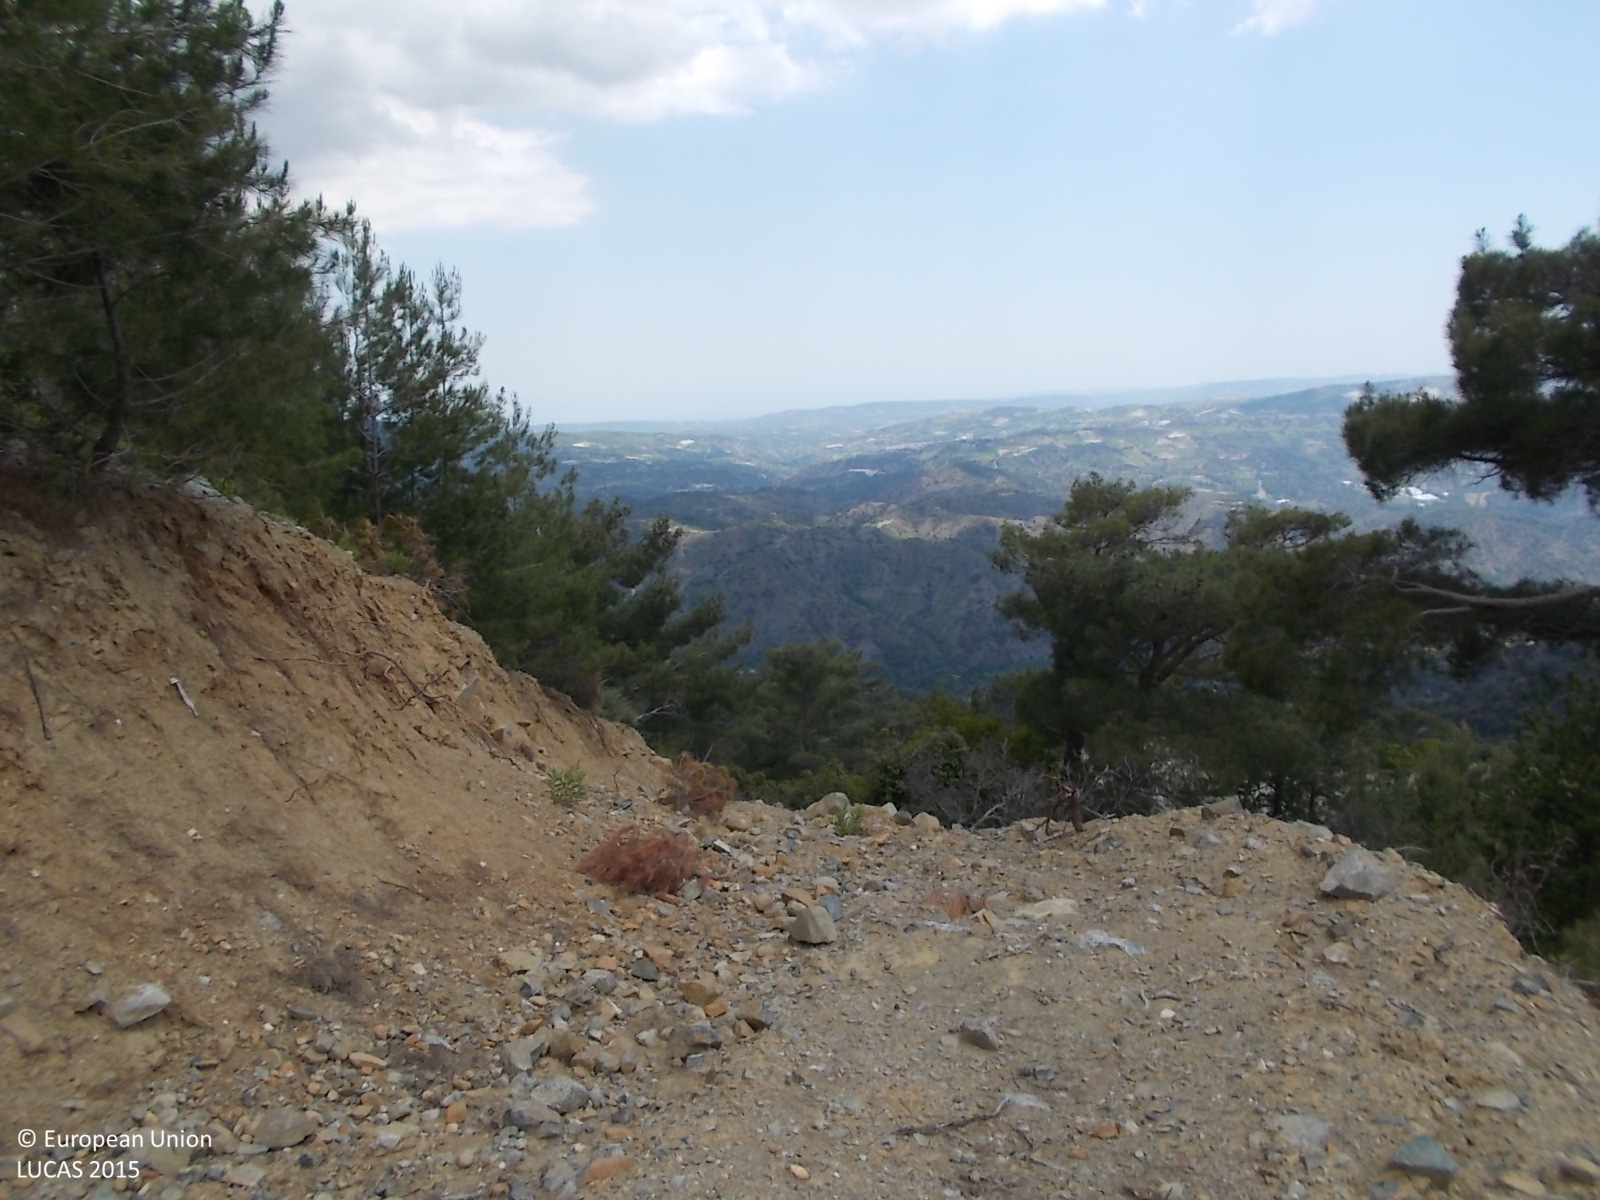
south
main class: Woodland
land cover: Pine dominated coniferous woodland
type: coniferous forest of the mediterranean region
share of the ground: > 75 %
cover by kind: coniferous forest trees 90 %, shrubs 5 %, unconsolidated bare surface 5 %
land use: Forestry
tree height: > 5 m
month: June
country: CY
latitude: 34.9119
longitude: 32.8316
